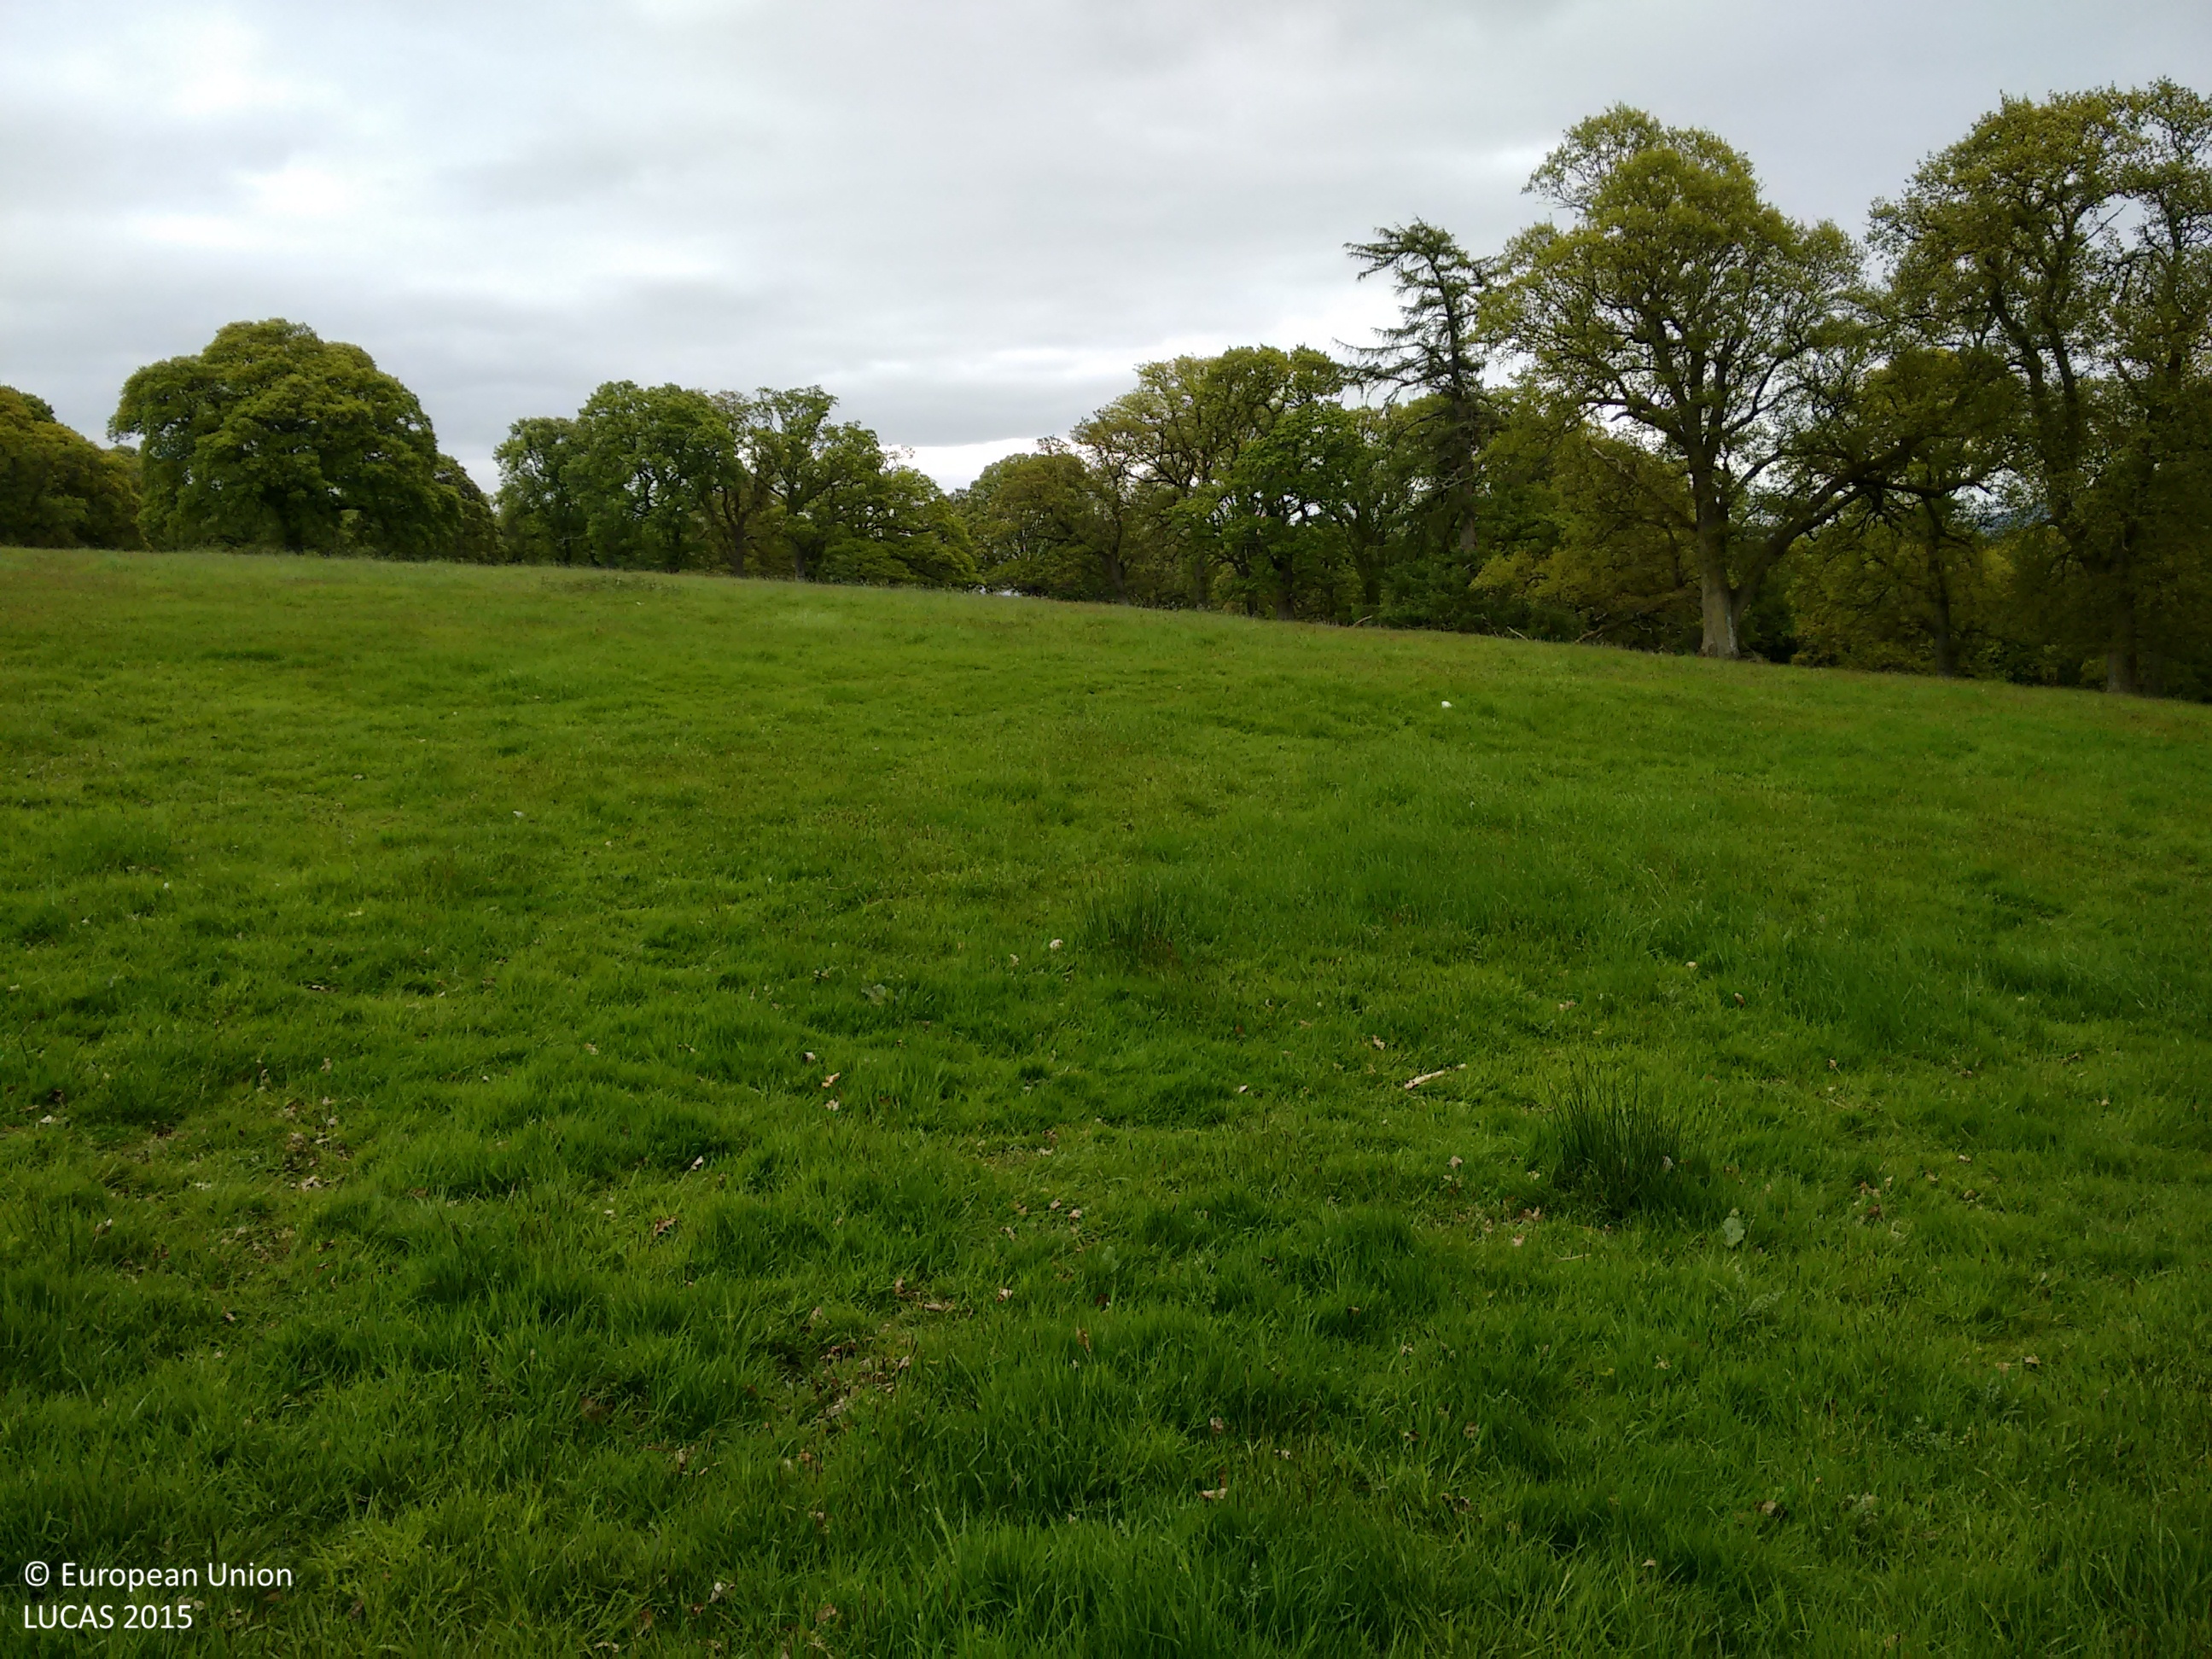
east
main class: Woodland
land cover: Broadleaved woodland
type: exotic forest
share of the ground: 10 - 25 %
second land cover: Grassland without tree/shrub cover
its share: > 75 %
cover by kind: herbaceous plants 80 %, broadleaved forest trees 20 %
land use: Agriculture (excluding fallow land and kitchen gardens)
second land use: Forestry
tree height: > 5 m
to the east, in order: Broadleaved woodland; Grassland without tree/shrub cover; Broadleaved woodland
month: May
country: GB
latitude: 56.3619
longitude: -3.5272
